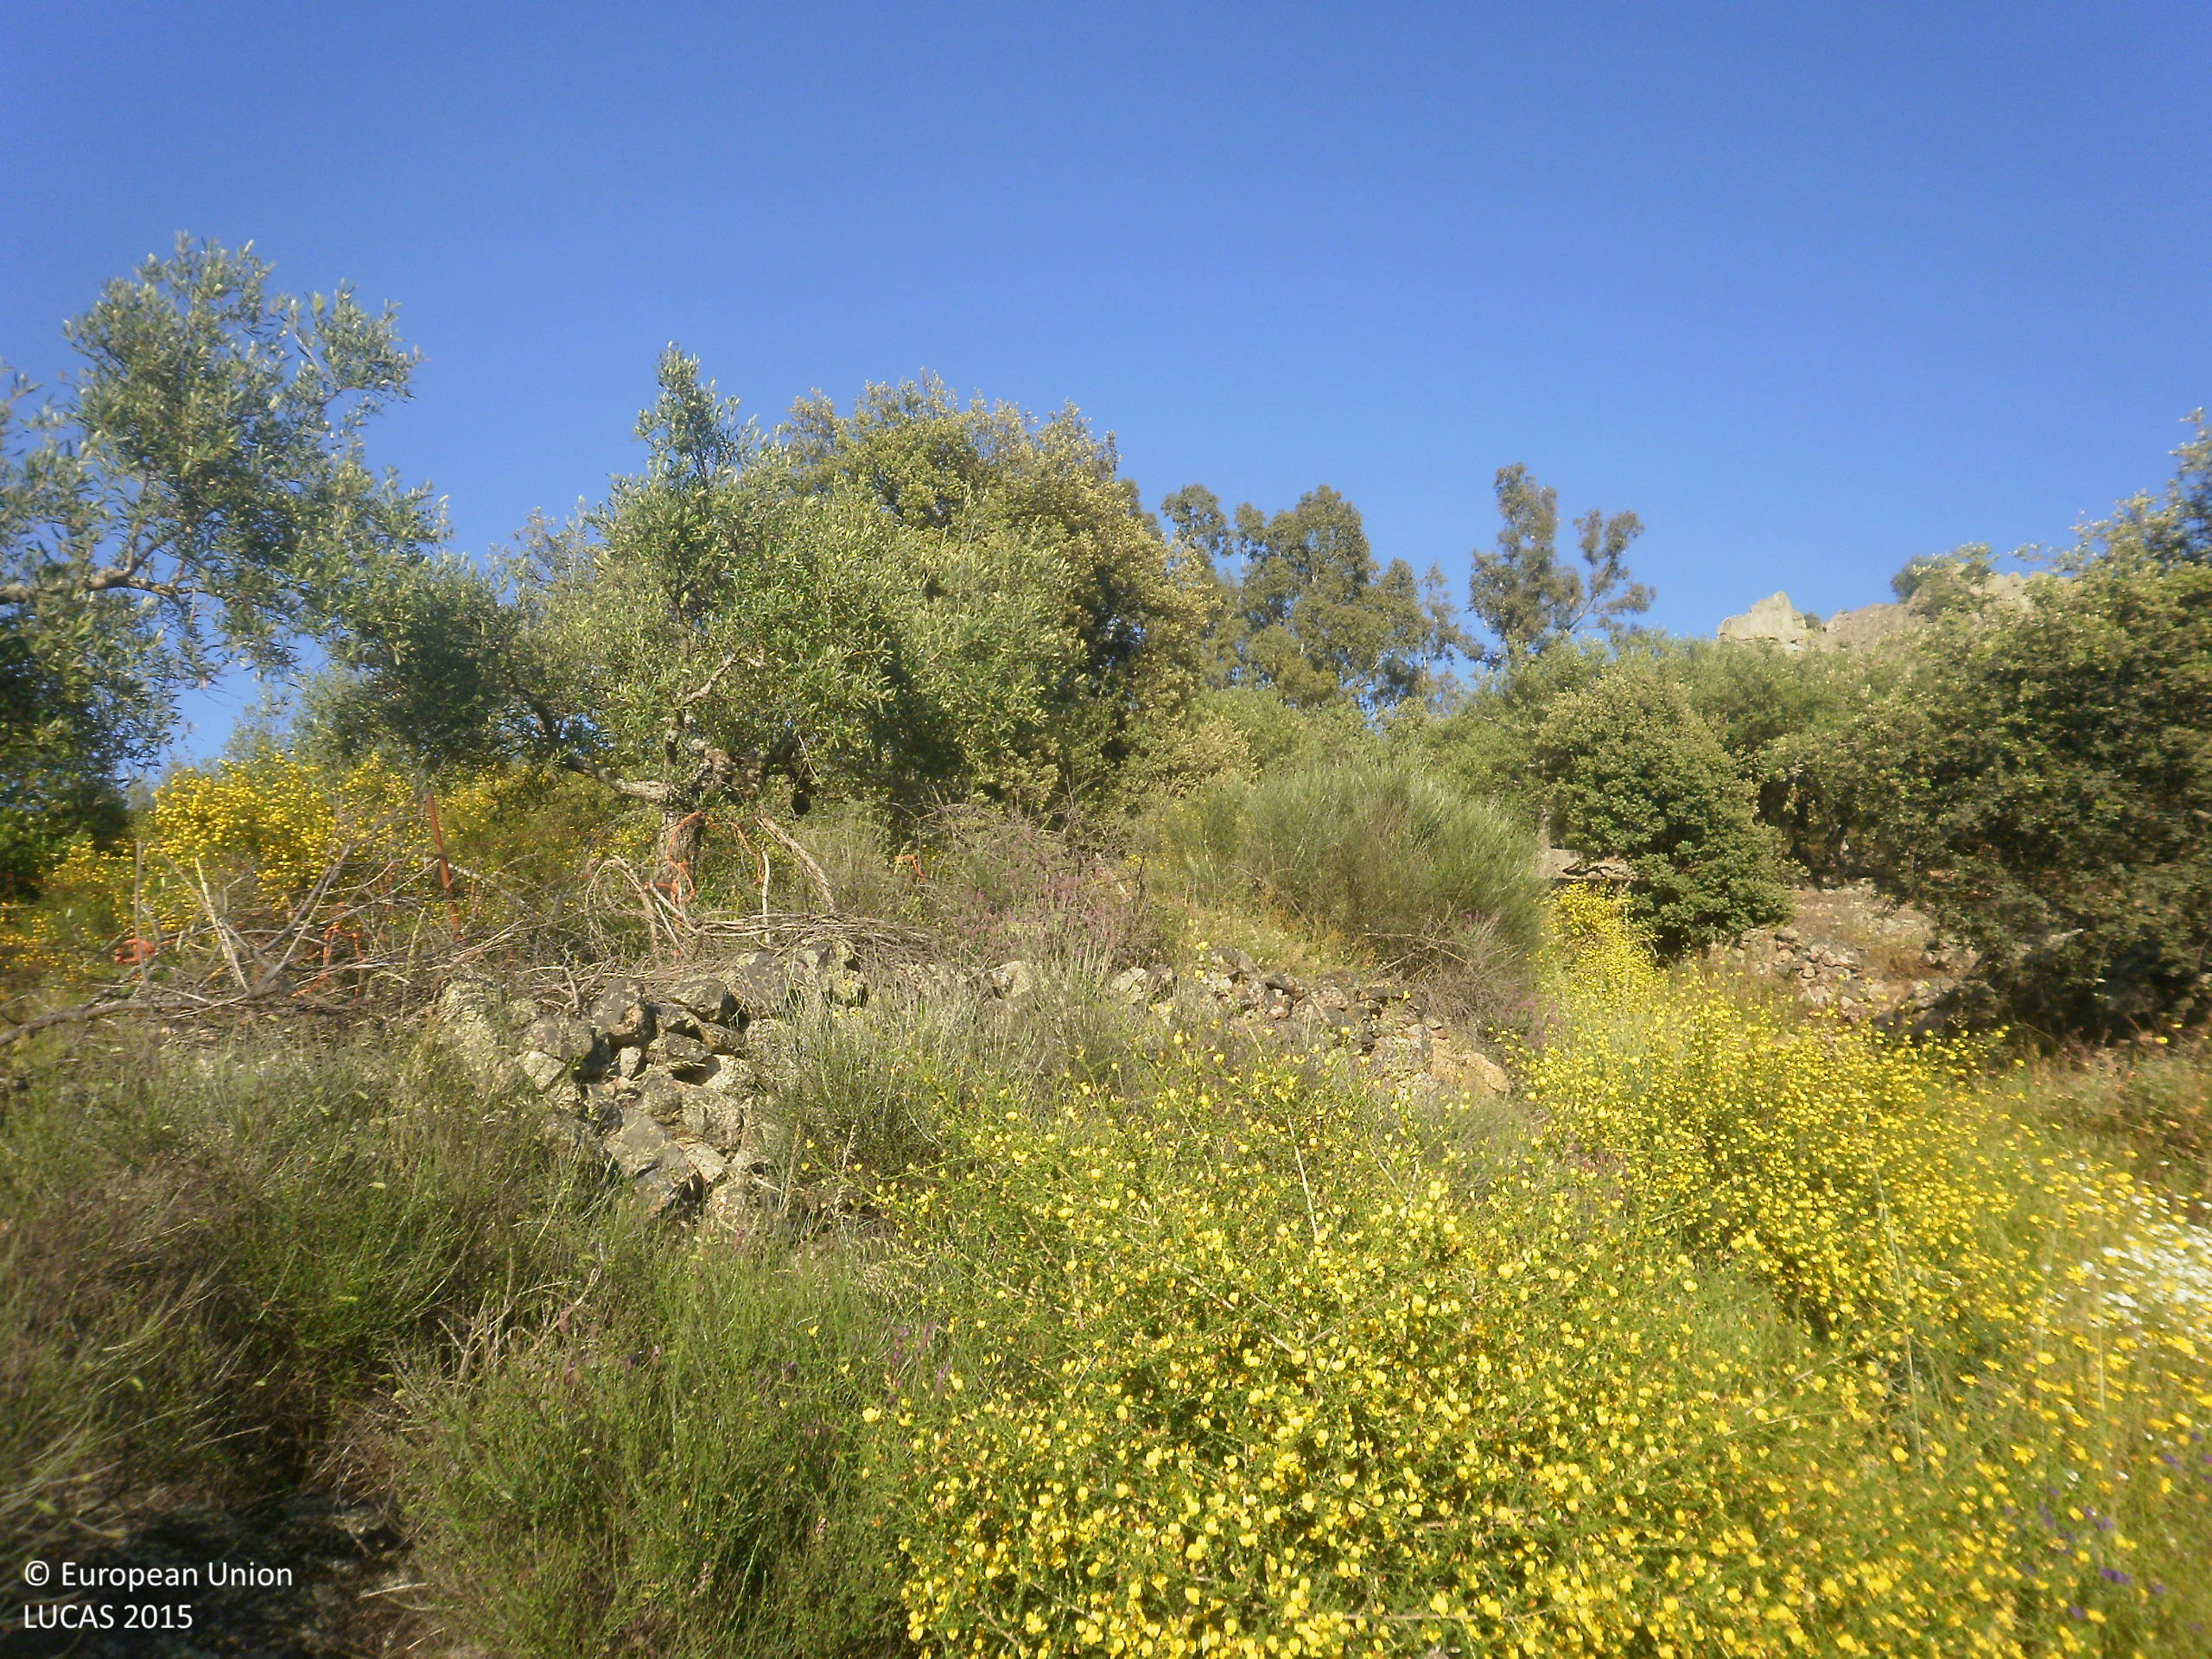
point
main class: Grassland
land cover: Grassland with sparse tree/shrub cover
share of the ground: > 75 %
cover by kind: herbaceous plants 90 %, broadleaved forest trees 5 %, shrubs 5 %
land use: Agriculture (excluding fallow land and kitchen gardens)
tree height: > 5 m
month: April
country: ES
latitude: 38.9591
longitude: -5.2370
